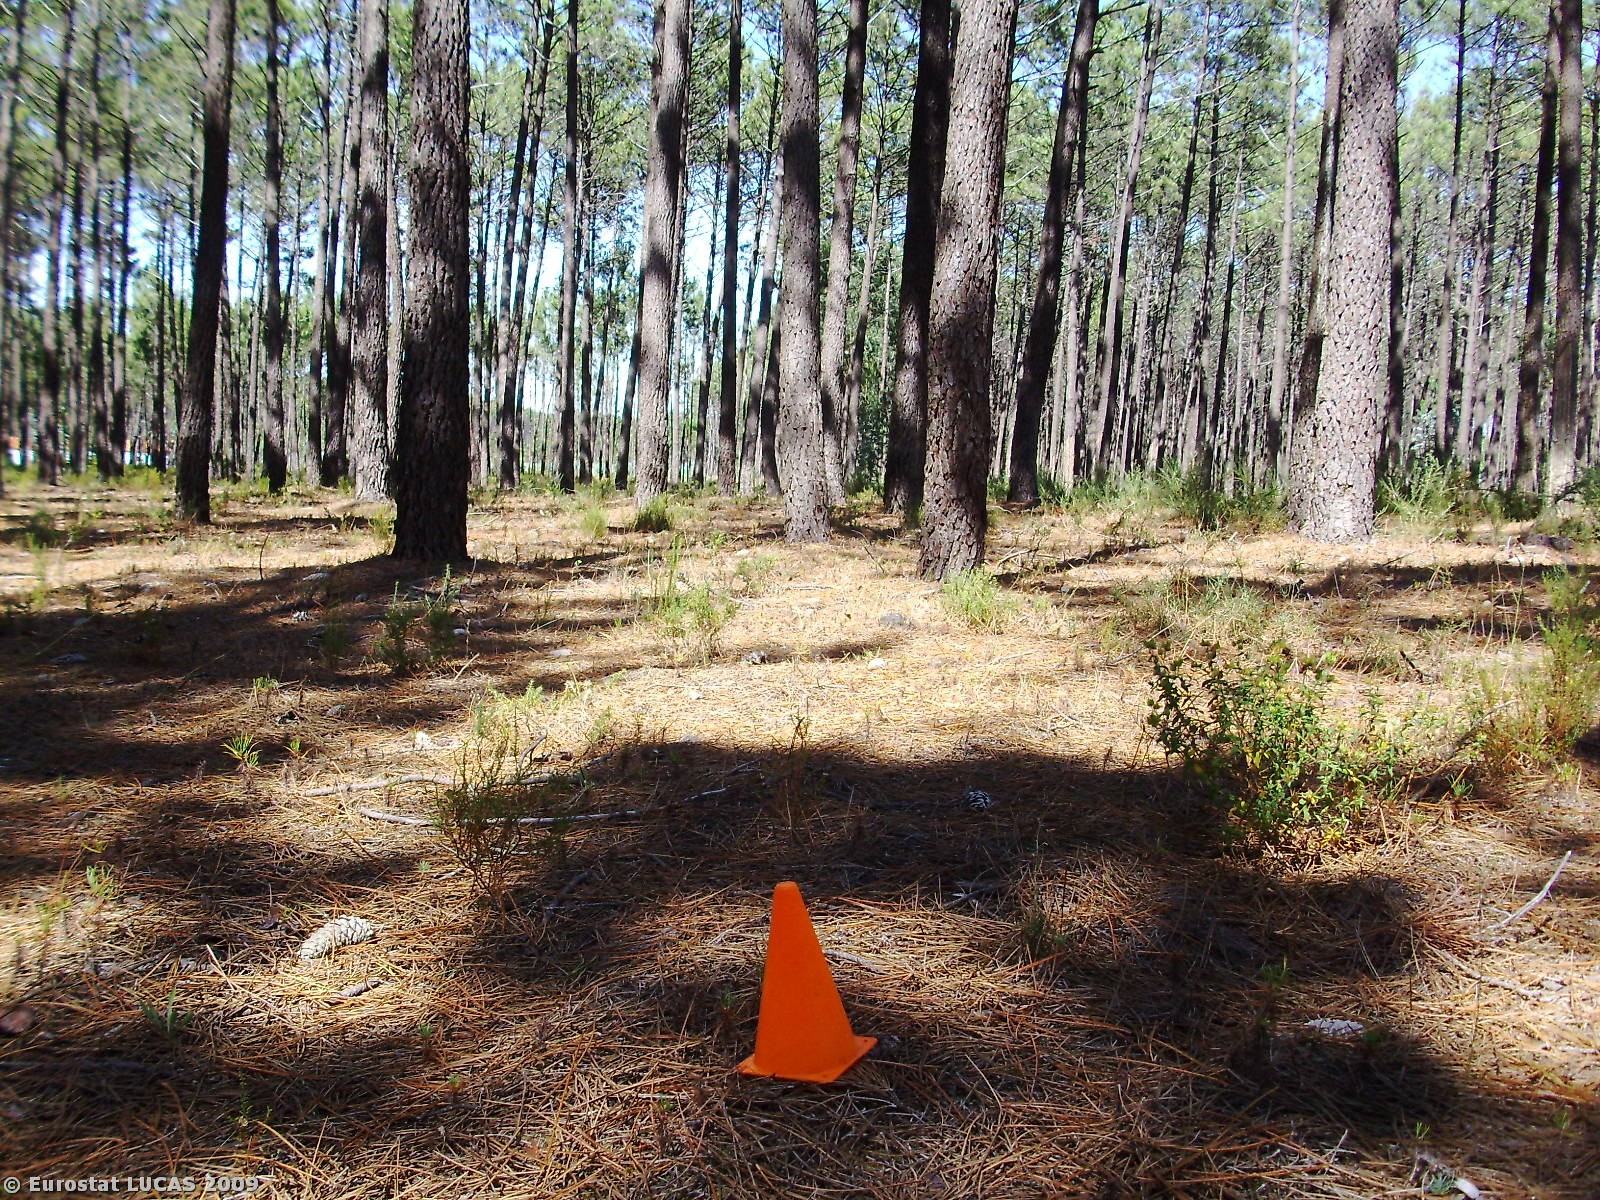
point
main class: Woodland
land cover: Coniferous woodland
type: coniferous forest of the mediterranean region
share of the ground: > 75 %
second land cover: Shrubland with sparse tree cover
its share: 10 - 25 %
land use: Forestry
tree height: > 5 m
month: July
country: PT
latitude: 39.7160
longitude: -8.9520
